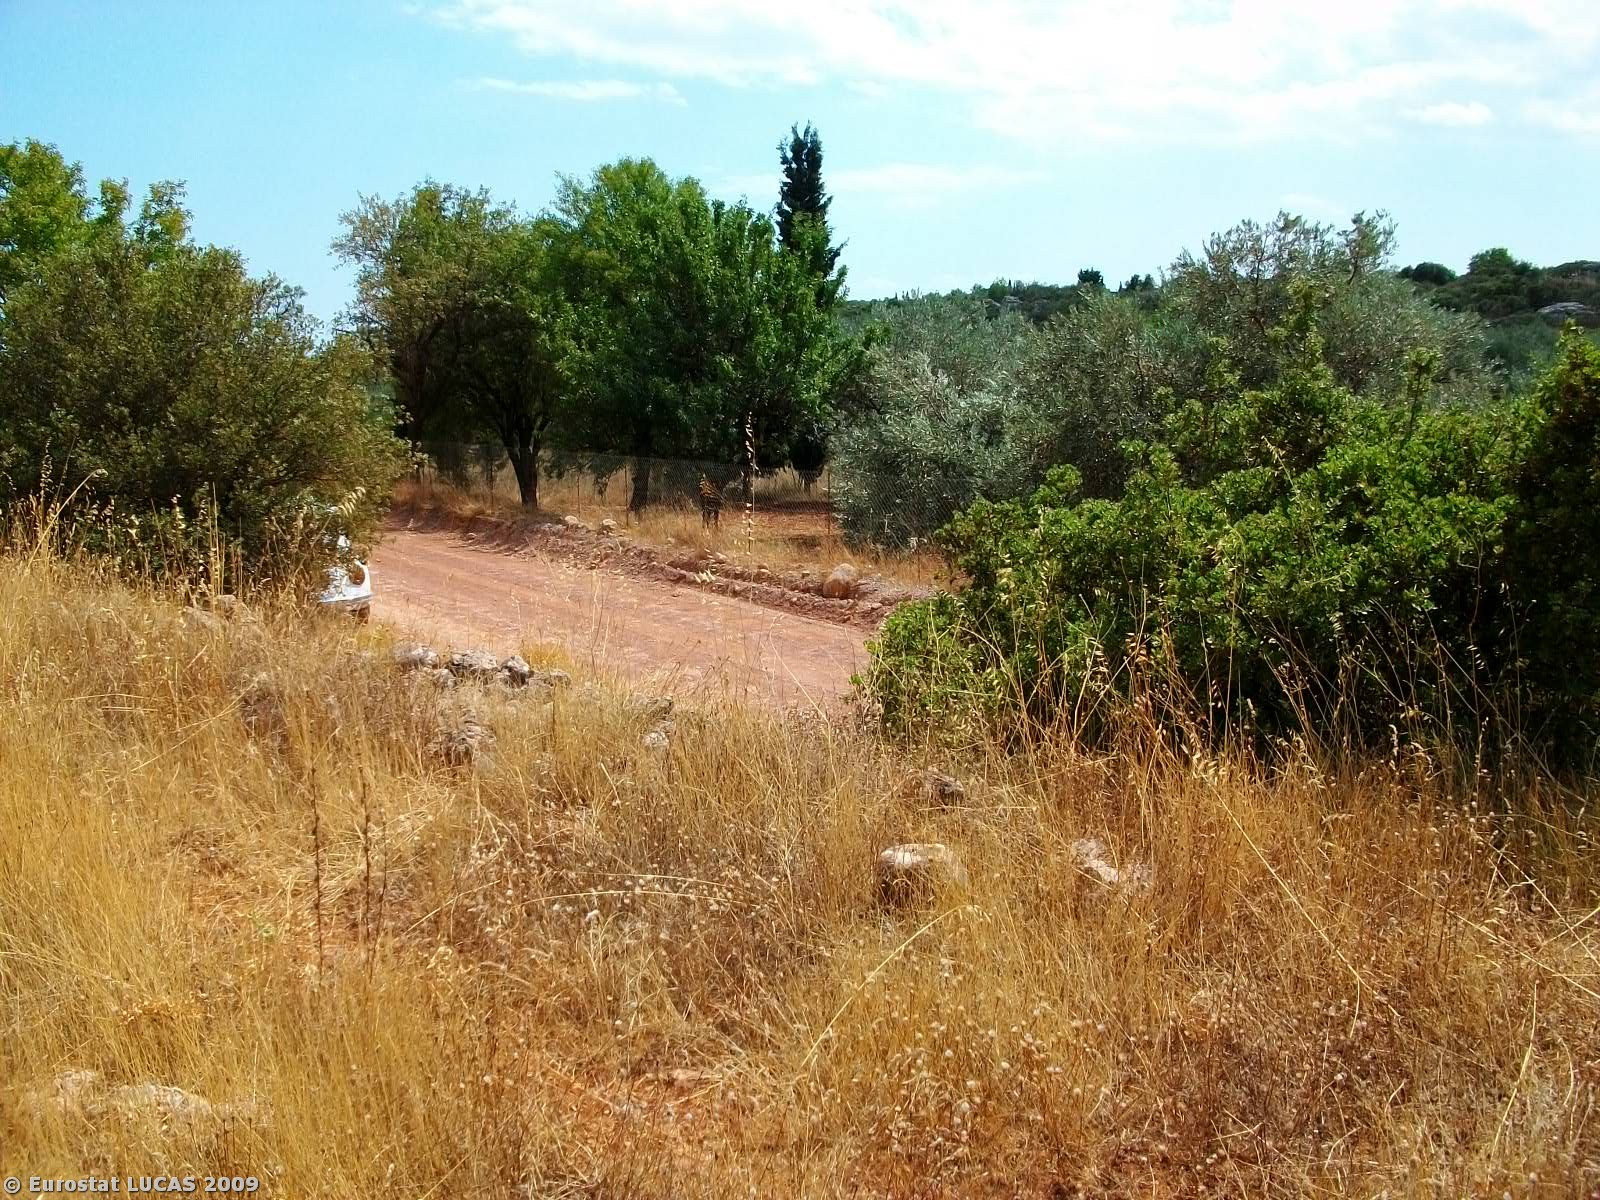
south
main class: Grassland
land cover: Grassland with sparse tree/shrub cover
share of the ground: > 75 %
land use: Agriculture (excluding fallow land and kitchen gardens)
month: August
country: GR
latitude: 38.4935
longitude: 22.3690
